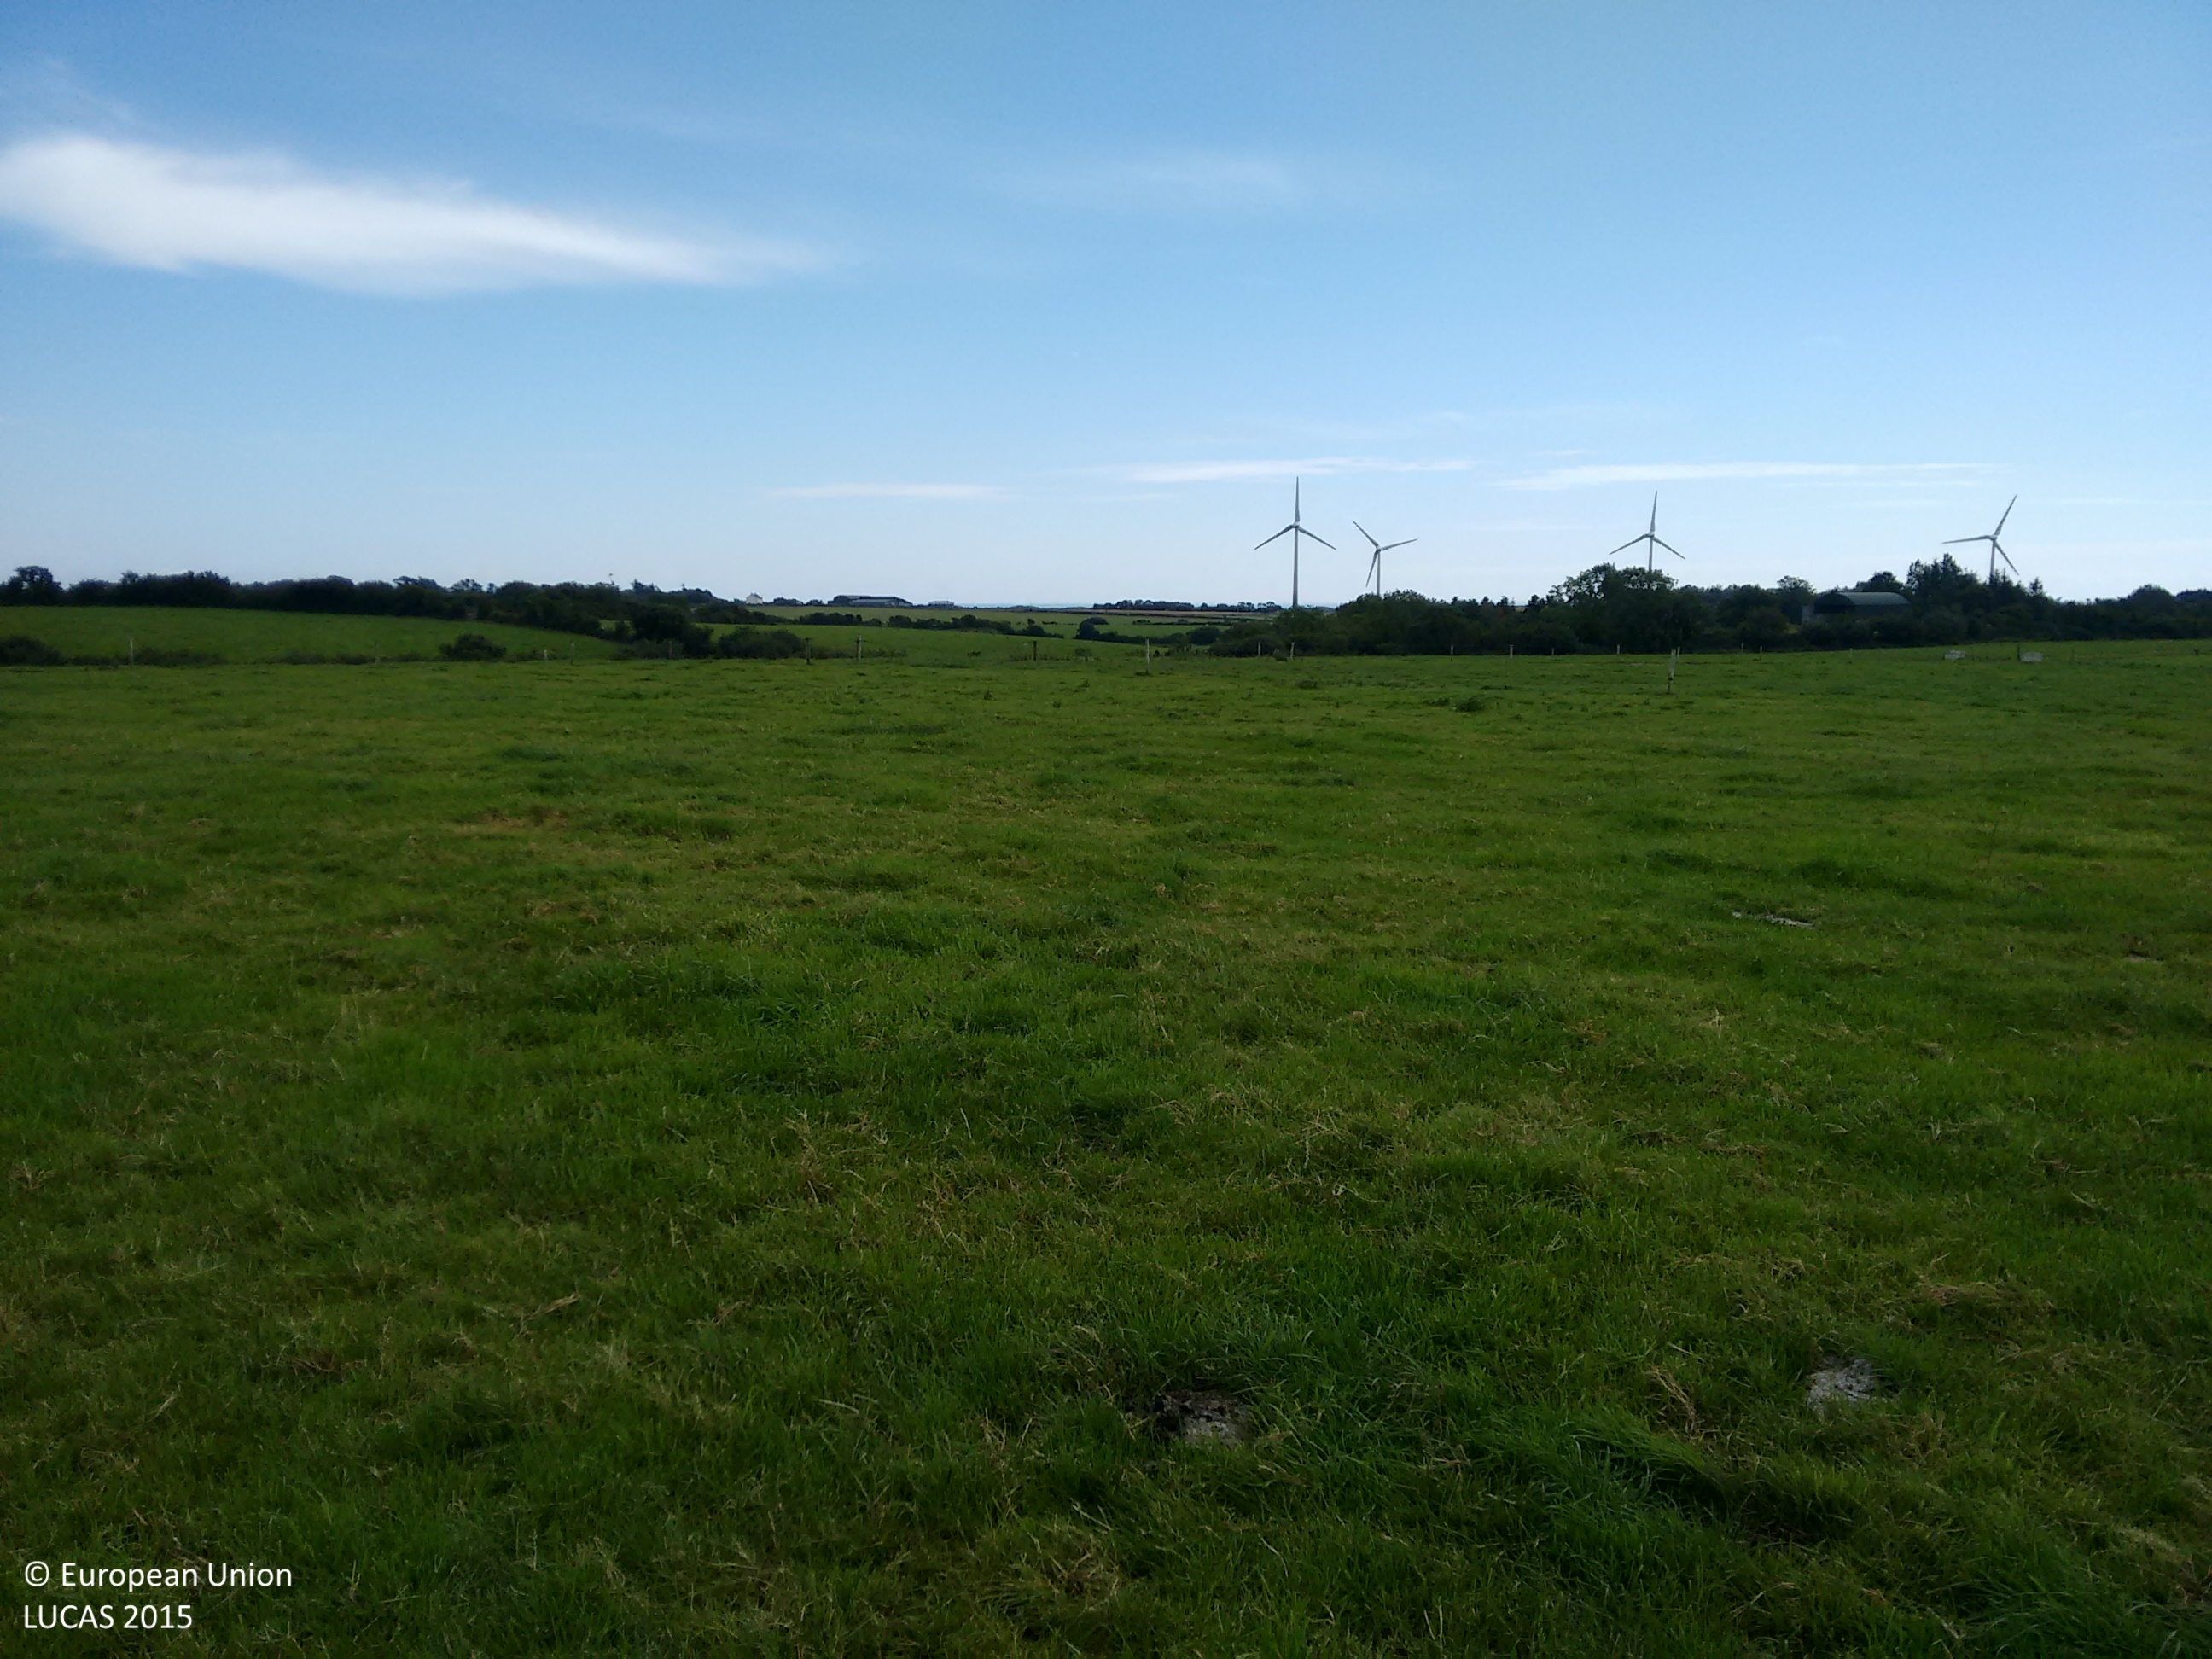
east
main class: Grassland
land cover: Grassland without tree/shrub cover
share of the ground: > 75 %
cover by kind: herbaceous plants 100 %
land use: Agriculture (excluding fallow land and kitchen gardens)
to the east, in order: Grassland without tree/shrub cover; Fences; Grassland without tree/shrub cover; Fences; Tracks; Fences; Grassland without tree/shrub cover; Fences; Grassland without tree/shrub cover; Ditches and canals; Abandoned hedges; Tracks; Grass margins; Managed hedges; Ditches and canals; Grassland without tree/shrub cover
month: August
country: IE
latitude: 52.5520
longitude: -6.2400
